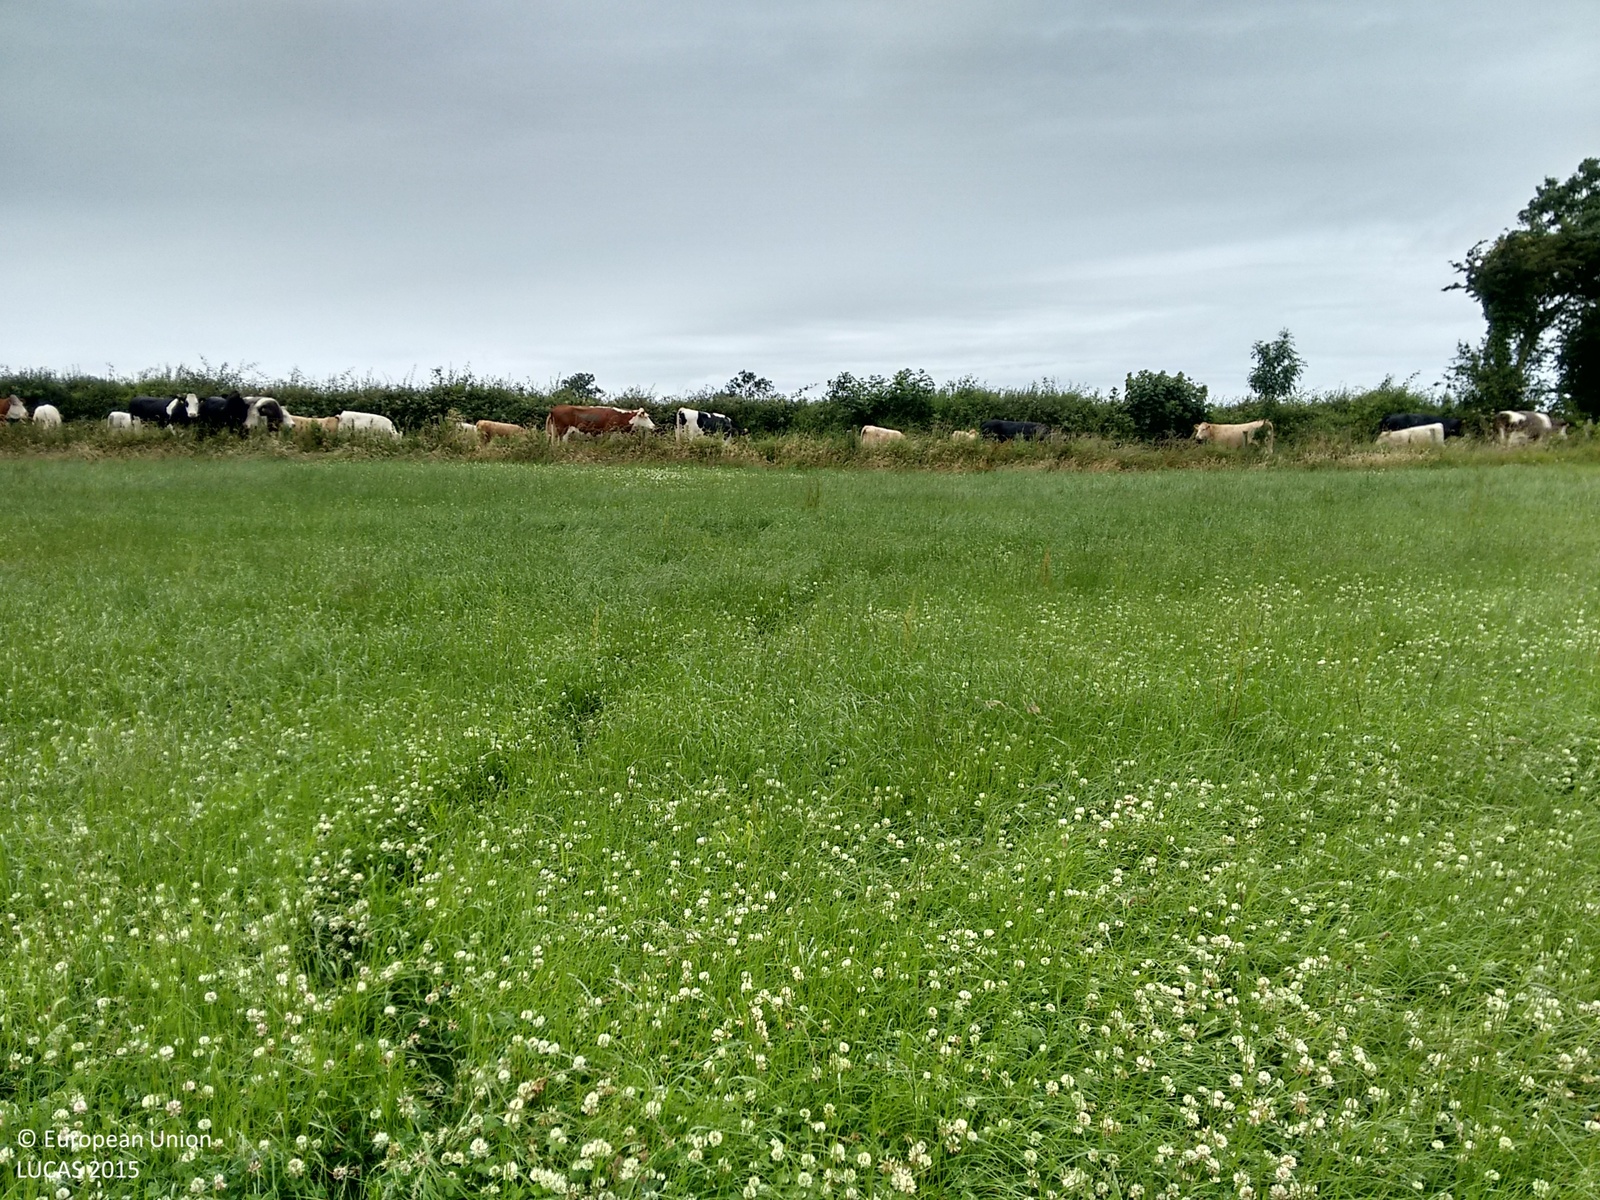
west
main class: Grassland
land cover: Grassland without tree/shrub cover
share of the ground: > 75 %
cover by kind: herbaceous plants 100 %
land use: Agriculture (excluding fallow land and kitchen gardens)
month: July
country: IE
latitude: 52.6863
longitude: -7.3591
